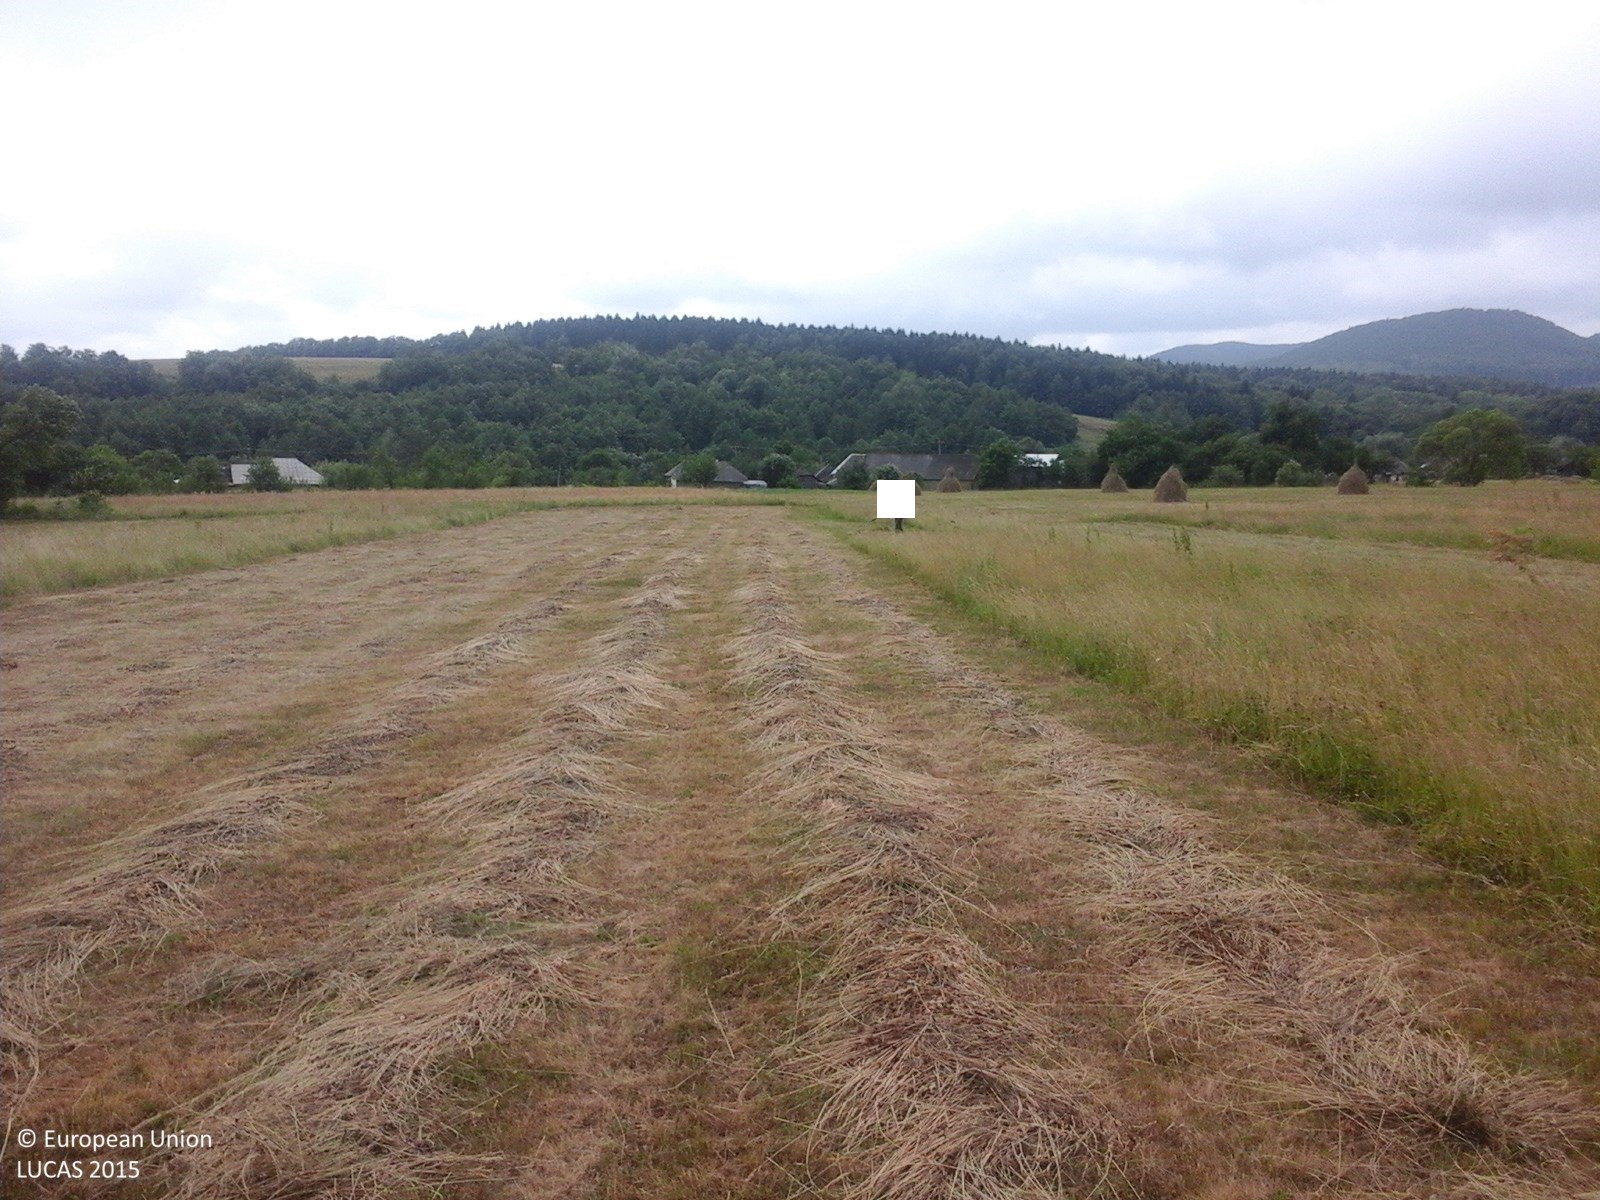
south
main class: Grassland
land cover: Grassland without tree/shrub cover
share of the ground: < 10 %
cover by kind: herbaceous plants 100 %
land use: Agriculture (excluding fallow land and kitchen gardens)
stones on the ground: < 10 %
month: June
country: RO
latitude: 47.2921
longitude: 26.3072
